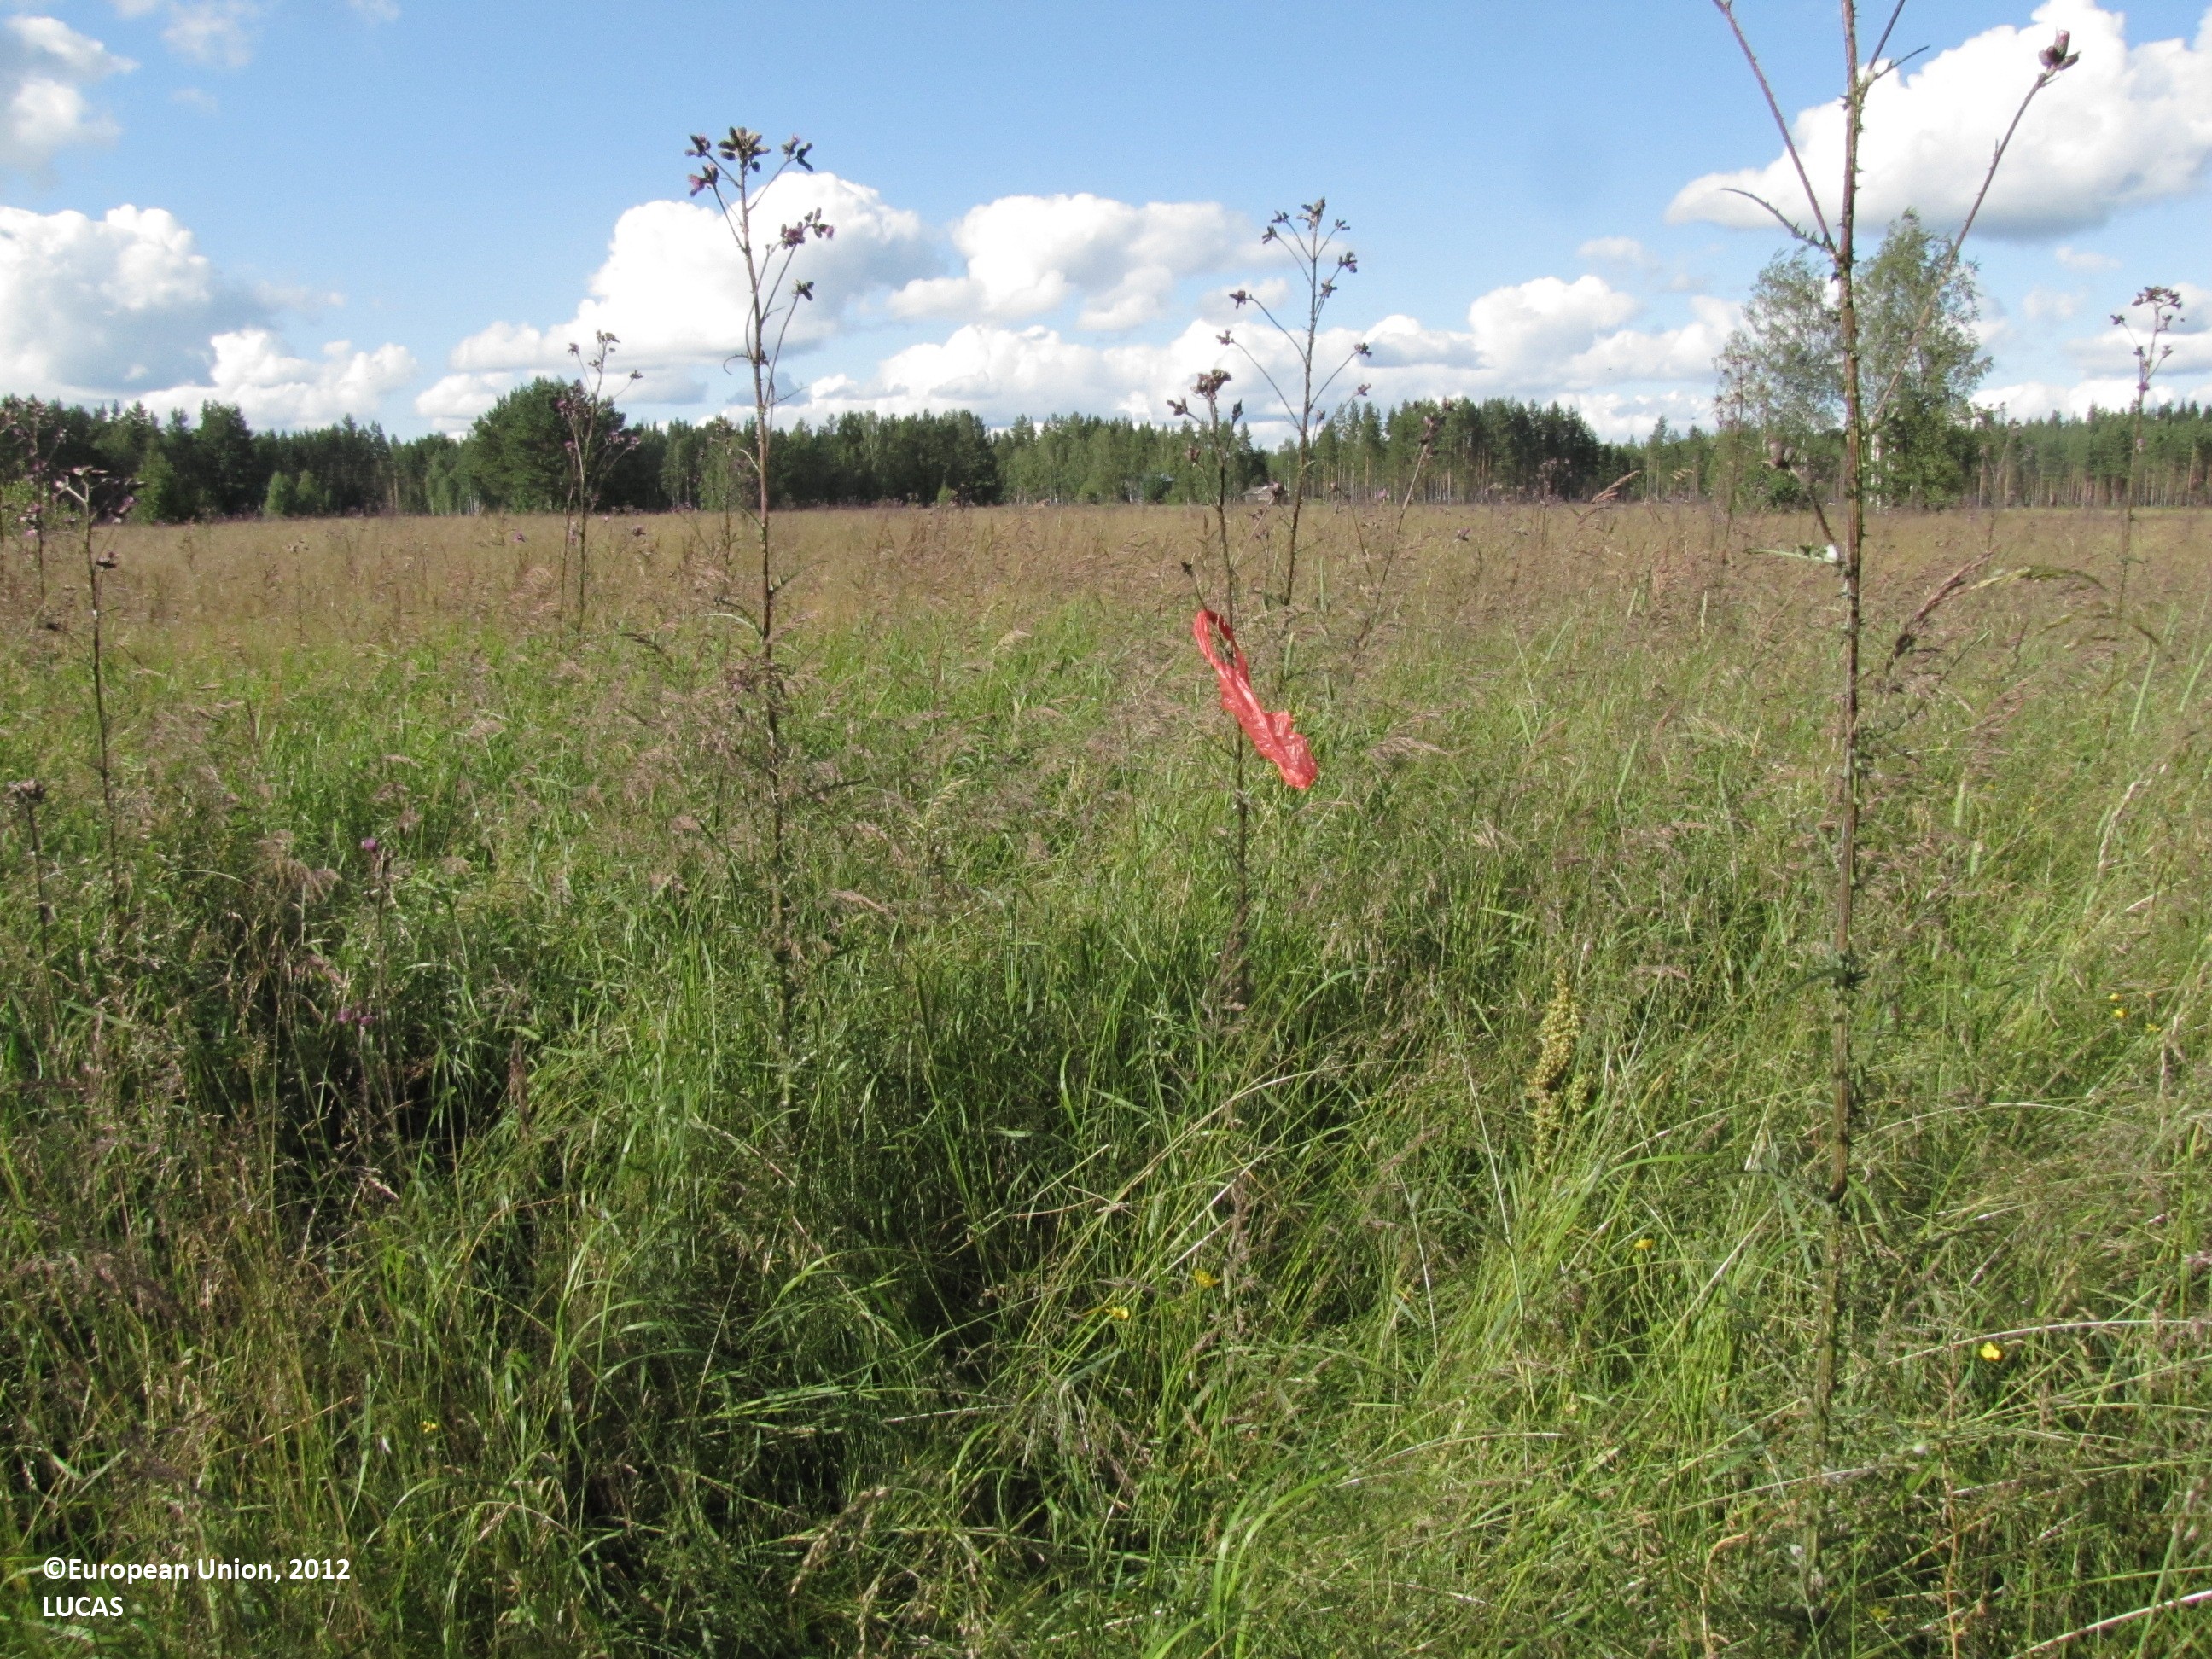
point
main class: Grassland
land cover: Grassland without tree/shrub cover
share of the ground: > 75 %
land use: Fallow land
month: July
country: FI
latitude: 62.5356
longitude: 23.2637
